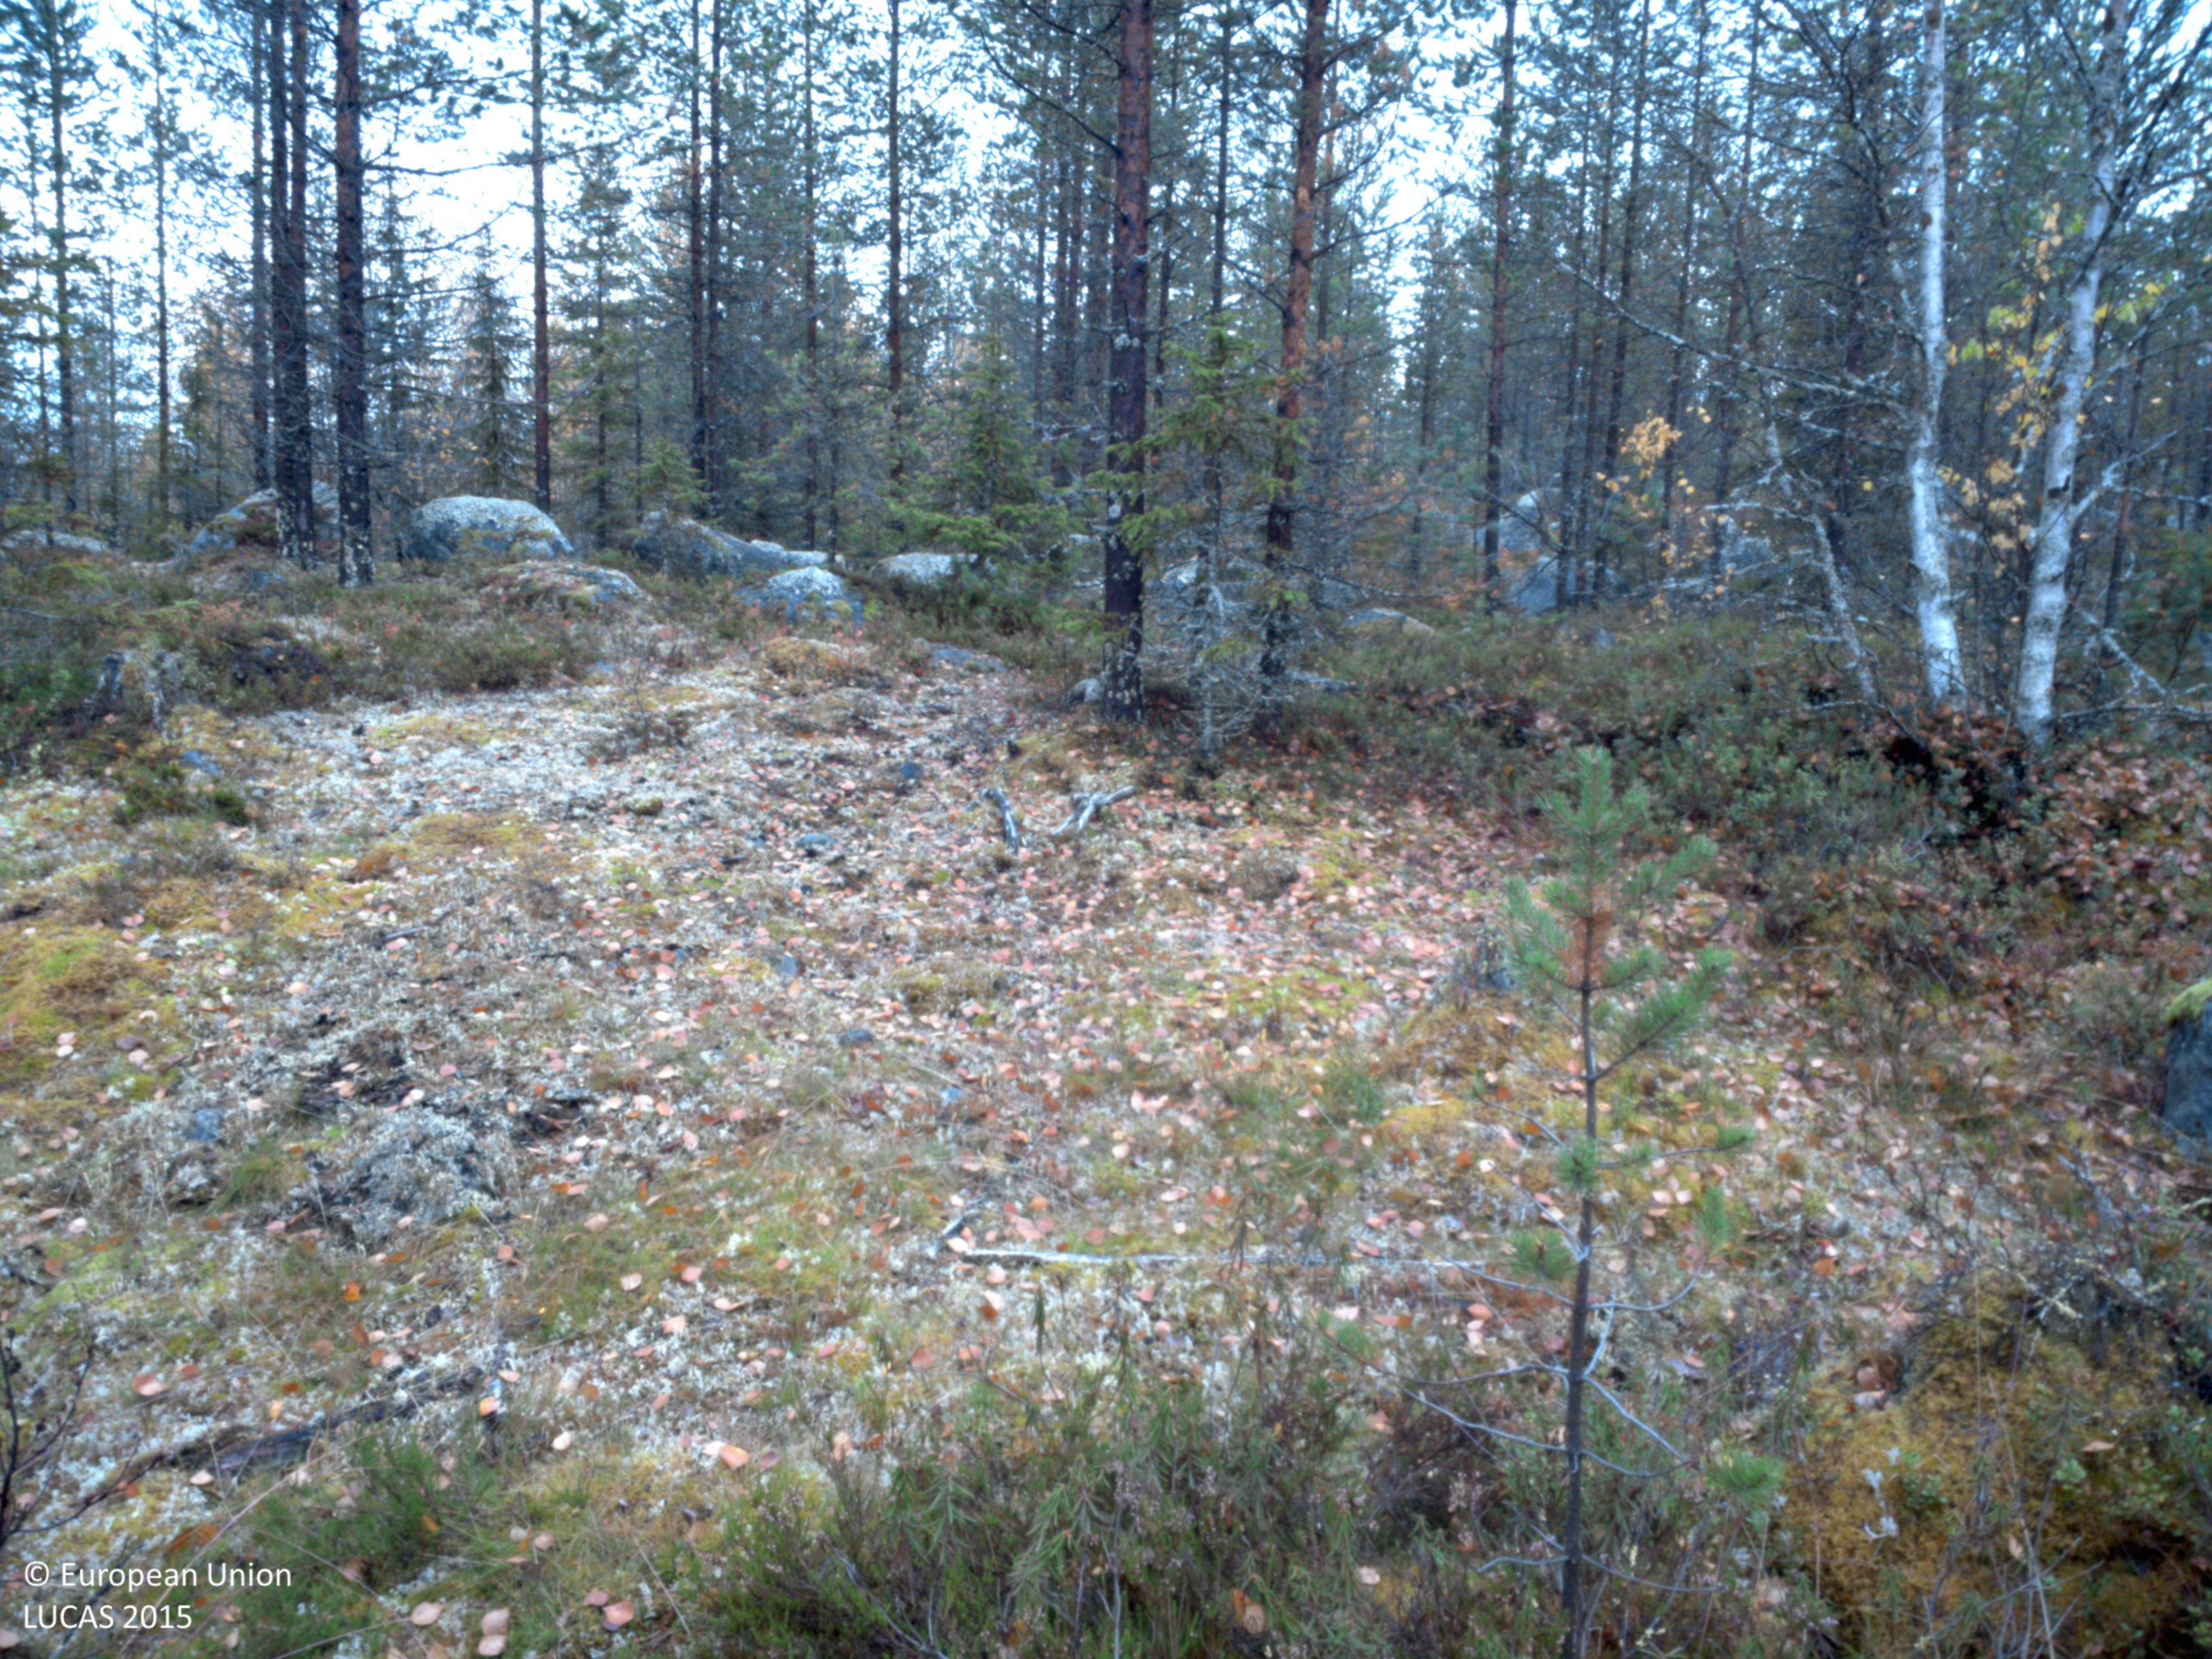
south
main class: Woodland
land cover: Pine dominated coniferous woodland
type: boreal forest
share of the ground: 50 - 75 %
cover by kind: coniferous forest trees 65 %, shrubs 20 %, broadleaved forest trees 5 %, herbaceous plants 5 %, lichens and mosses 5 %
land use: Forestry
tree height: > 5 m
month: September
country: SE
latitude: 64.8871
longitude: 19.0259
